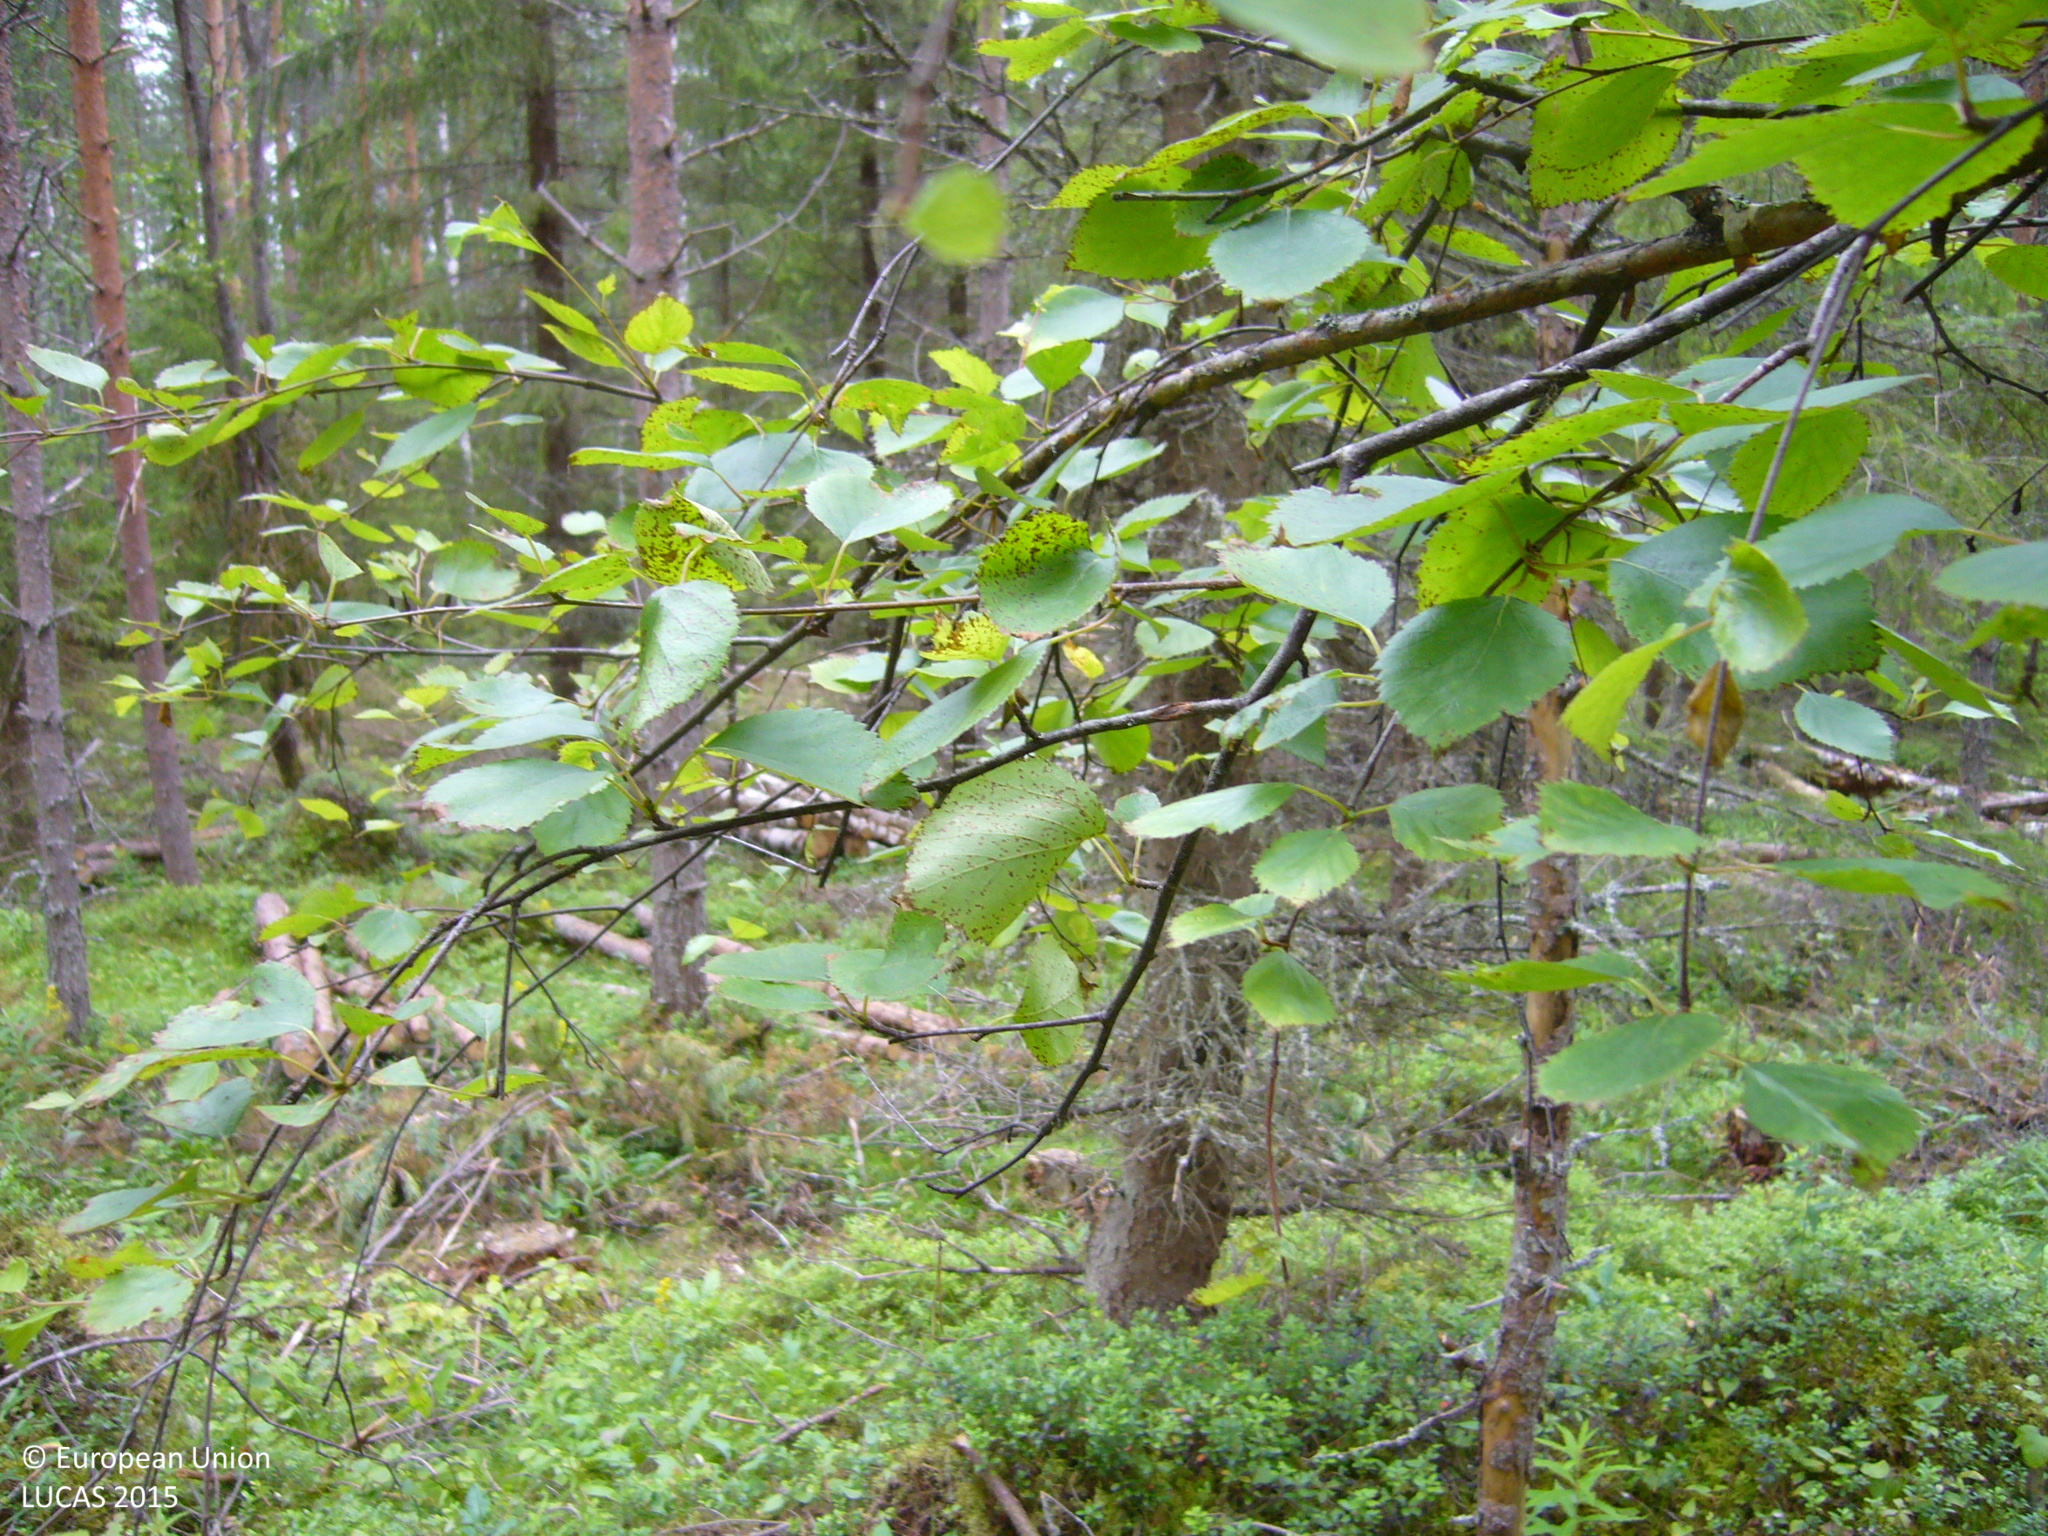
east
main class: Woodland
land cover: Pine dominated coniferous woodland
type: boreal forest
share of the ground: 50 - 75 %
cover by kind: coniferous forest trees 50 %, shrubs 45 %, broadleaved forest trees 5 %
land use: Forestry
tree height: > 5 m
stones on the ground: < 10 %
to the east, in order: Pine dominated coniferous woodland; Tracks; Pine dominated coniferous woodland; Spruce dominated coniferous woodland; Tracks; Ditches and canals; Spruce dominated mixed woodland; Pine dominated mixed woodland; Spruce dominated mixed woodland; Ditches and canals; Spruce dominated mixed woodland; Pine dominated mixed woodland; Ditches and canals; Pine dominated mixed woodland
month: July
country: FI
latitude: 63.9292
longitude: 26.7078
